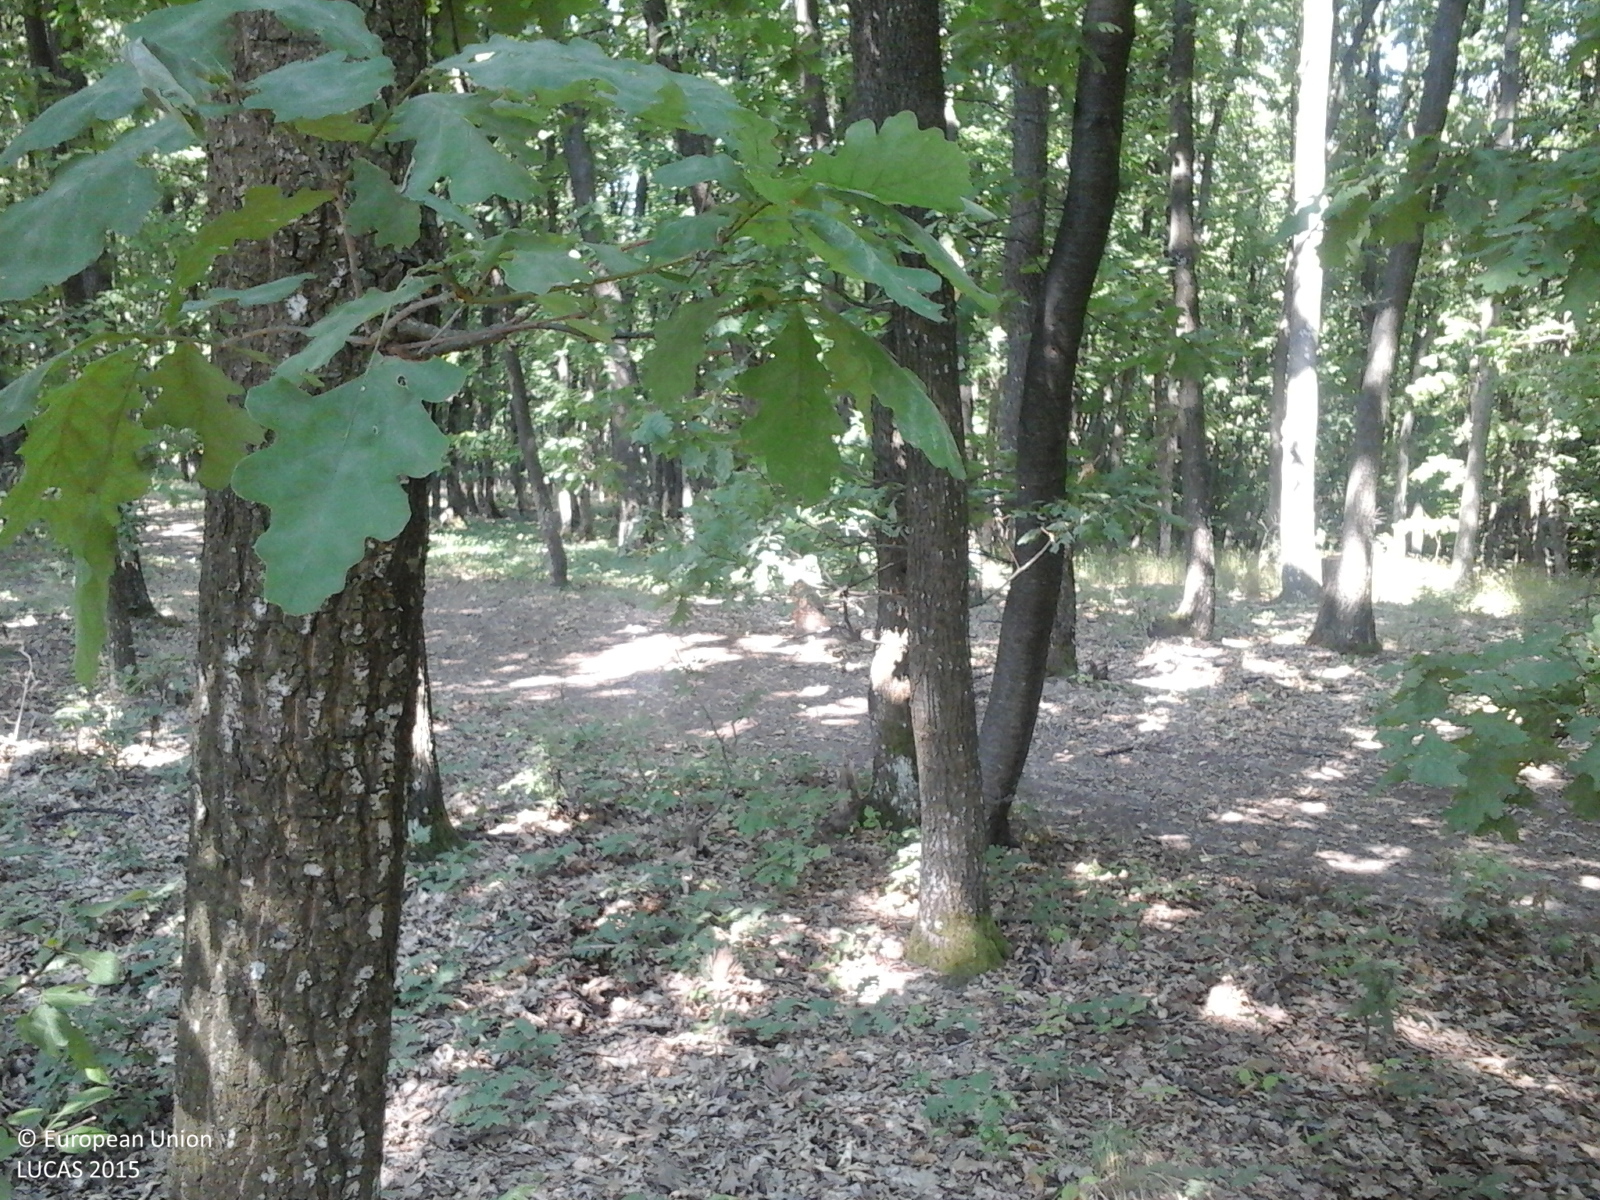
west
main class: Woodland
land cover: Broadleaved woodland
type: acidophilous oak and oak-birch forest
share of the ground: > 75 %
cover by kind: broadleaved forest trees 100 %
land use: Forestry
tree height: > 5 m
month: July
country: RO
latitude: 44.8186
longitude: 24.5546
